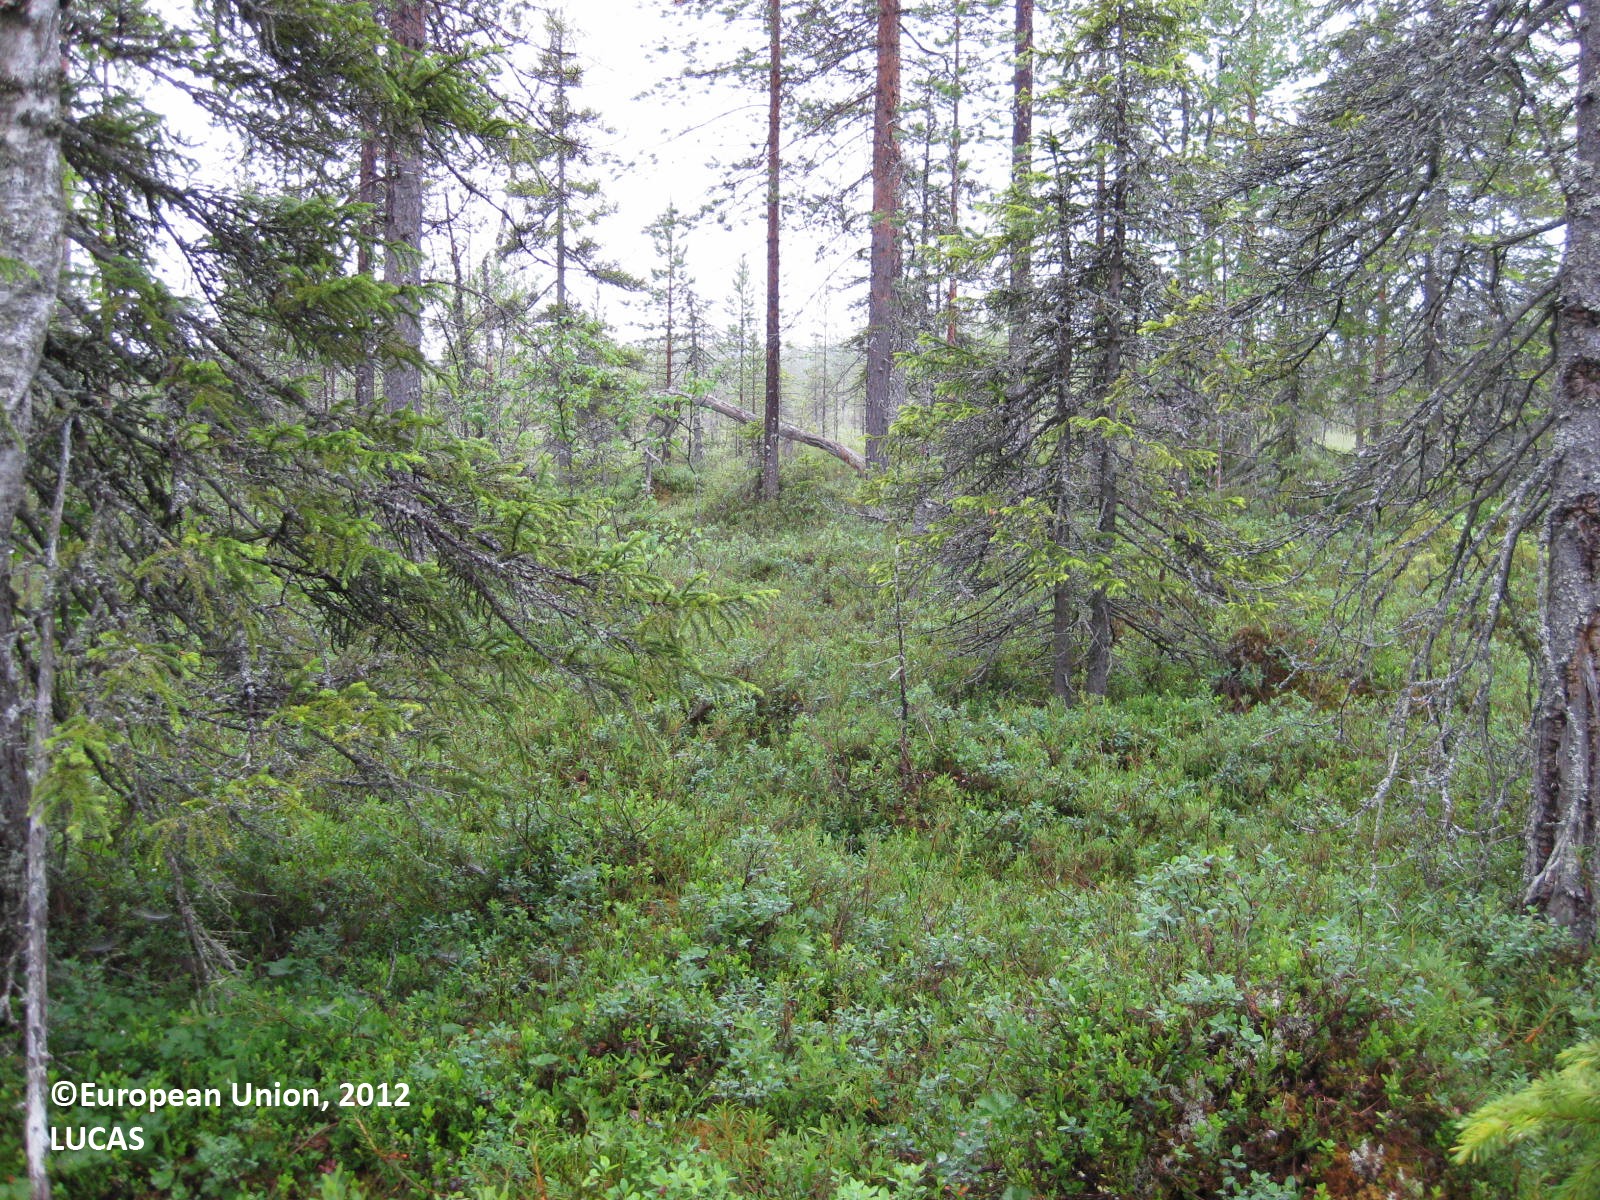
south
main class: Woodland
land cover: Pine dominated coniferous woodland
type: boreal forest
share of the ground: > 75 %
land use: Forestry
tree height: > 5 m
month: July
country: FI
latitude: 65.6216
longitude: 28.4168
